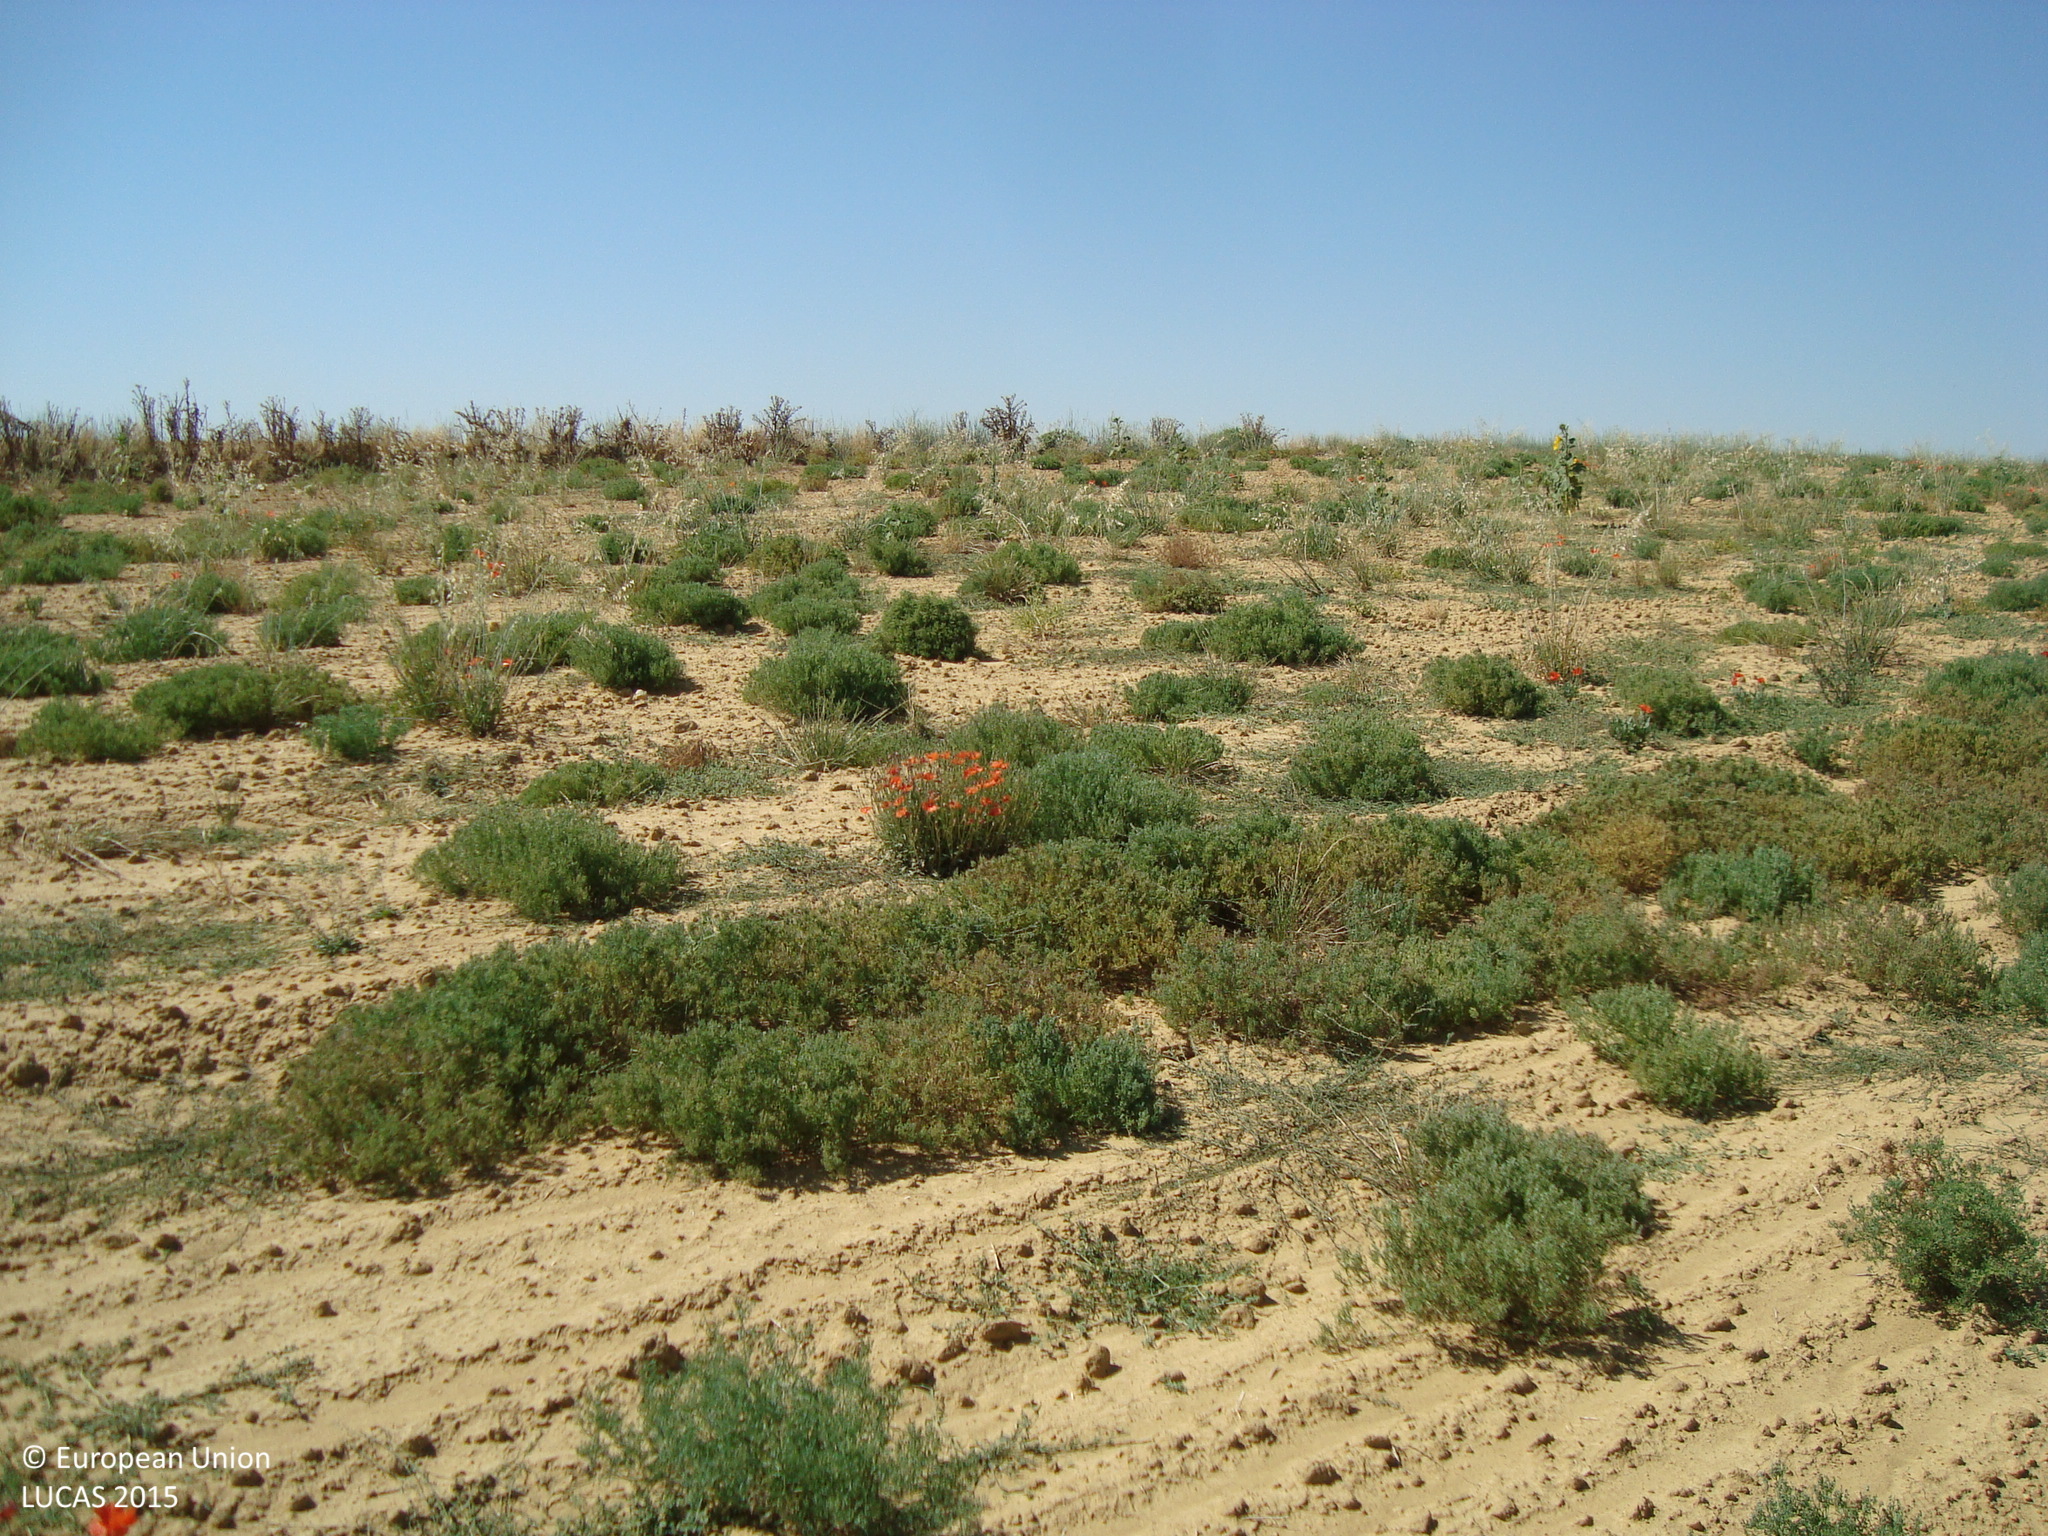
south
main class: Grassland
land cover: Spontaneously vegetated surfaces
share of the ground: 25 - 50 %
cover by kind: unconsolidated bare surface 60 %, herbaceous plants 40 %
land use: Abandoned areas
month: July
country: ES
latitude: 42.0576
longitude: -4.7810
